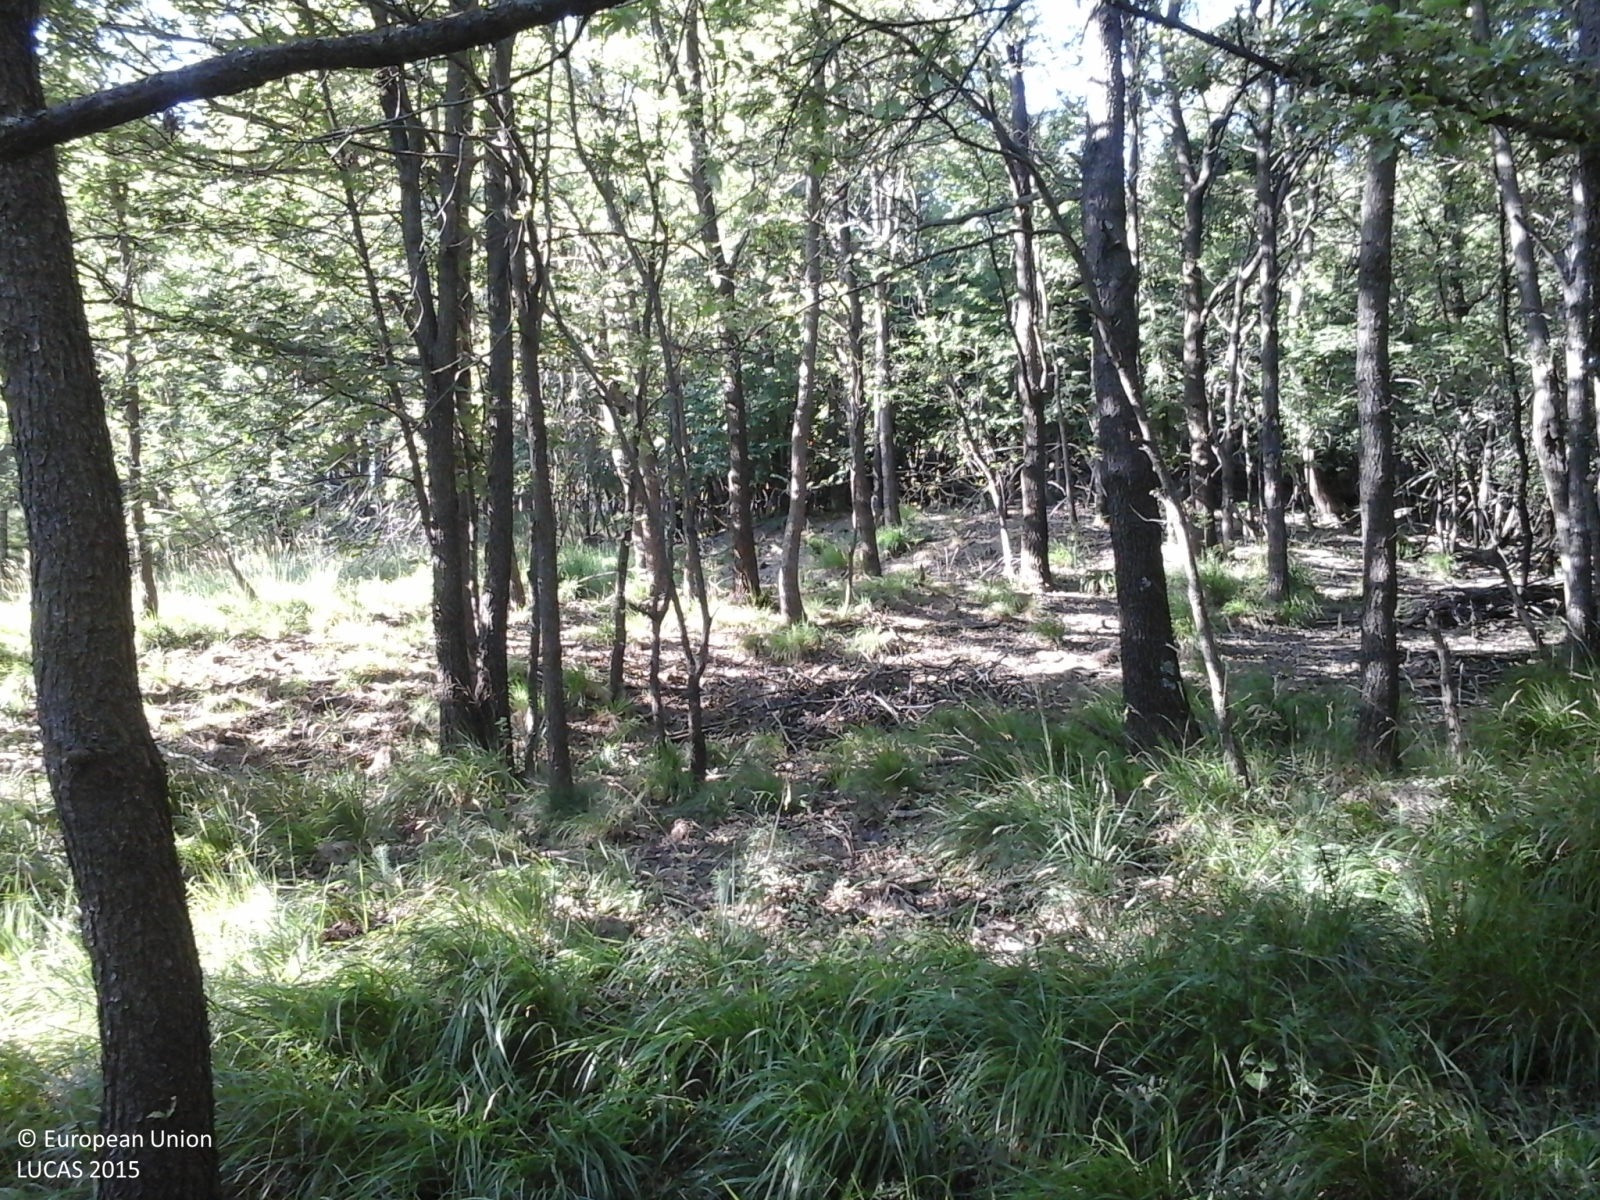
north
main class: Woodland
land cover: Broadleaved woodland
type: thermophilous deciduous forest
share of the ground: > 75 %
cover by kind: broadleaved forest trees 100 %
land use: Forestry
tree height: > 5 m
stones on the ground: < 10 %
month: June
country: IT
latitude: 44.6323
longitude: 8.8050
